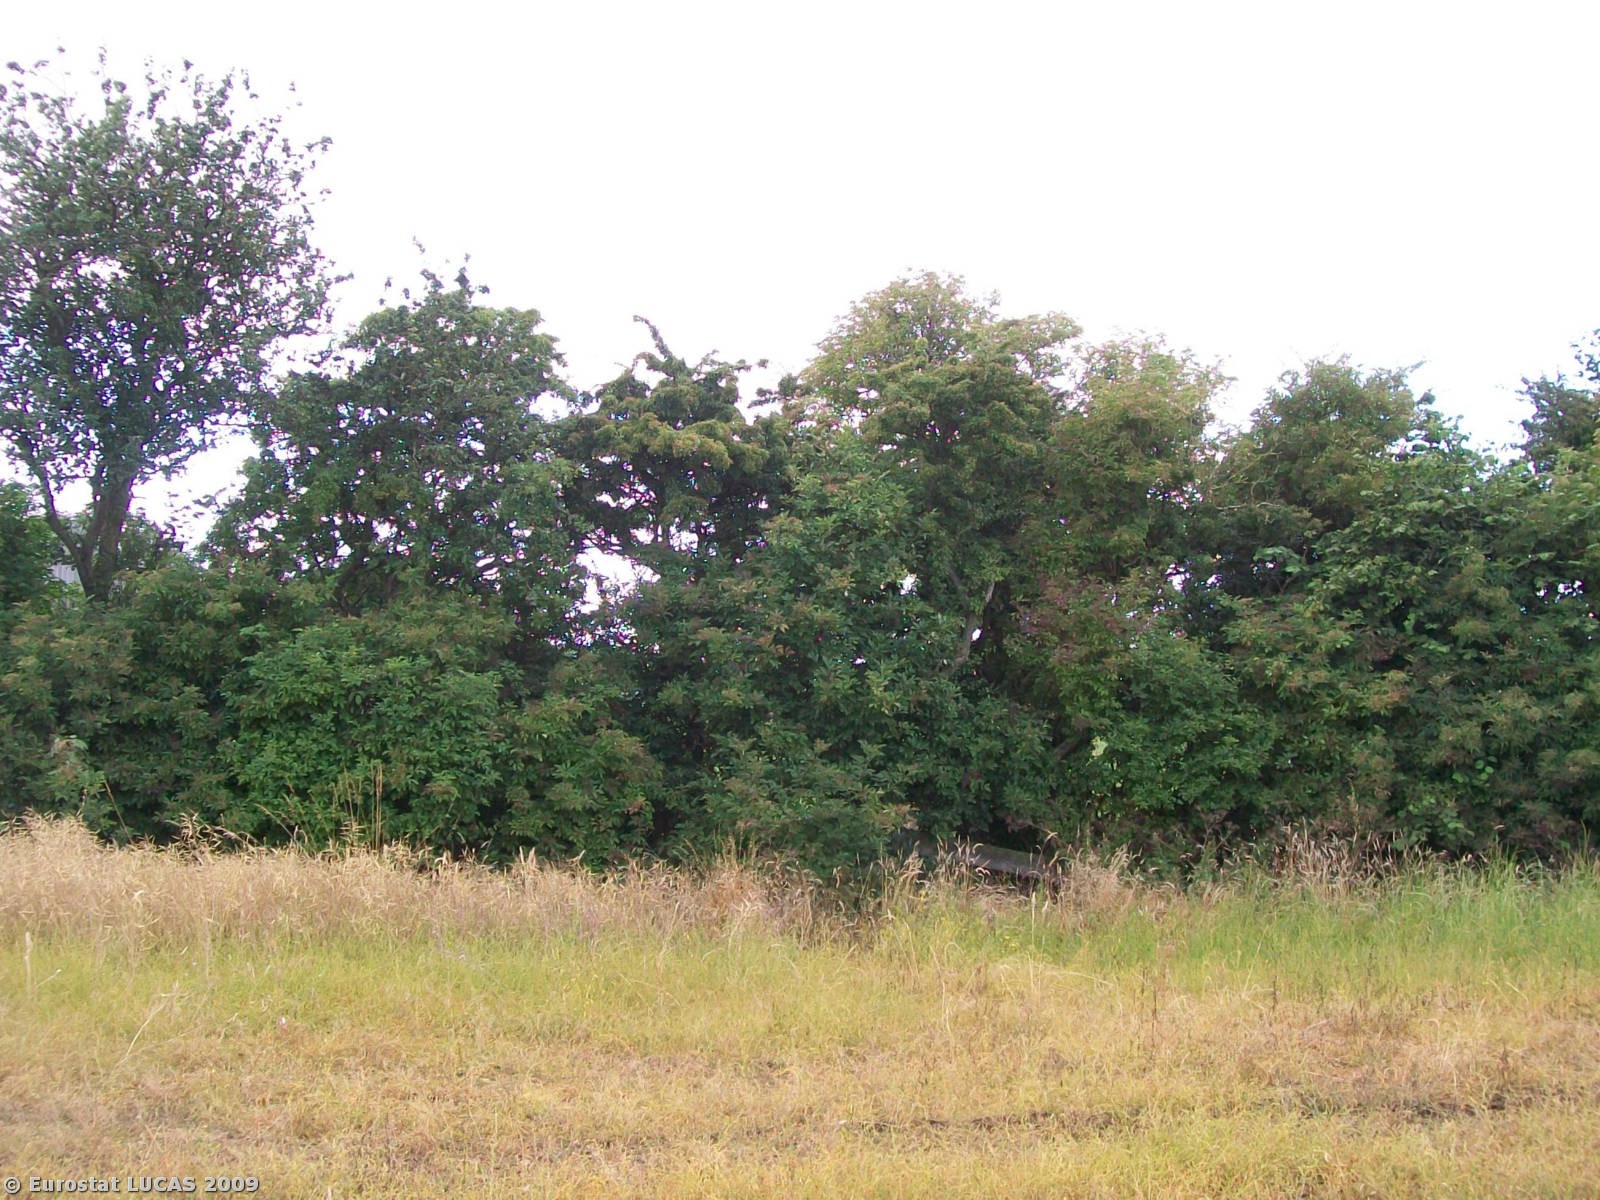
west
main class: Cropland
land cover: Rape and turnip rape
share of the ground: < 10 %
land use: Agriculture (excluding fallow land and kitchen gardens)
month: August
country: GB
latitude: 54.4933
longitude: -1.2380
